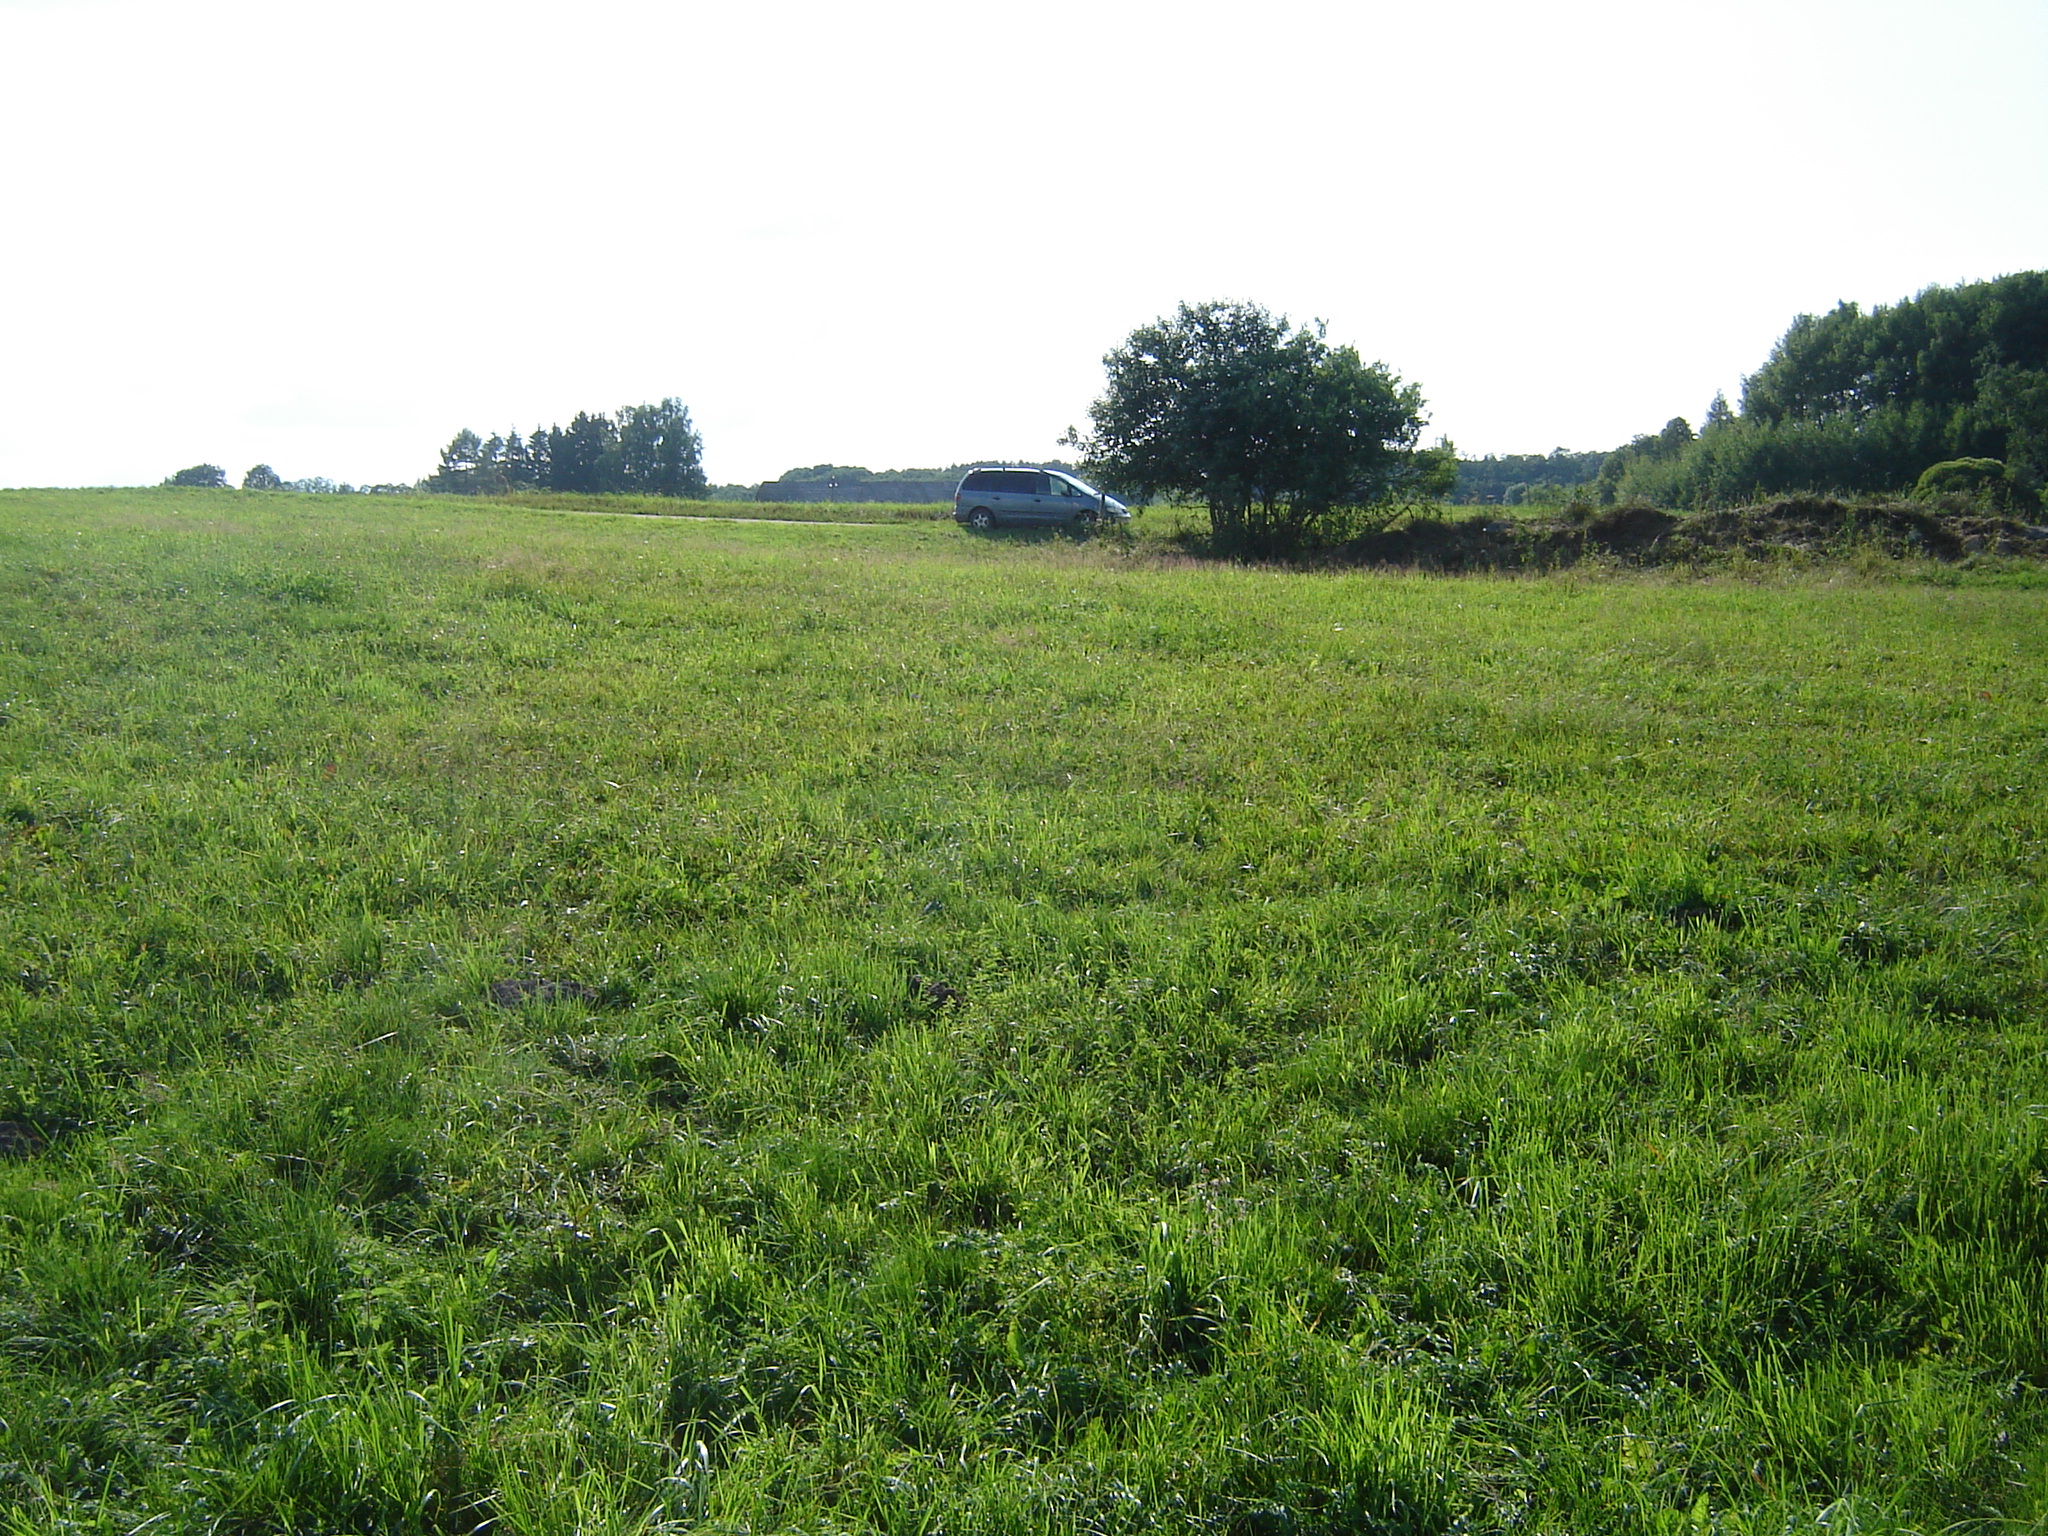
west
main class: Grassland
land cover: Grassland without tree/shrub cover
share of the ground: > 75 %
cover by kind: herbaceous plants 100 %
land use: Agriculture (excluding fallow land and kitchen gardens)
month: July
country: LT
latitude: 55.3125
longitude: 25.4866
